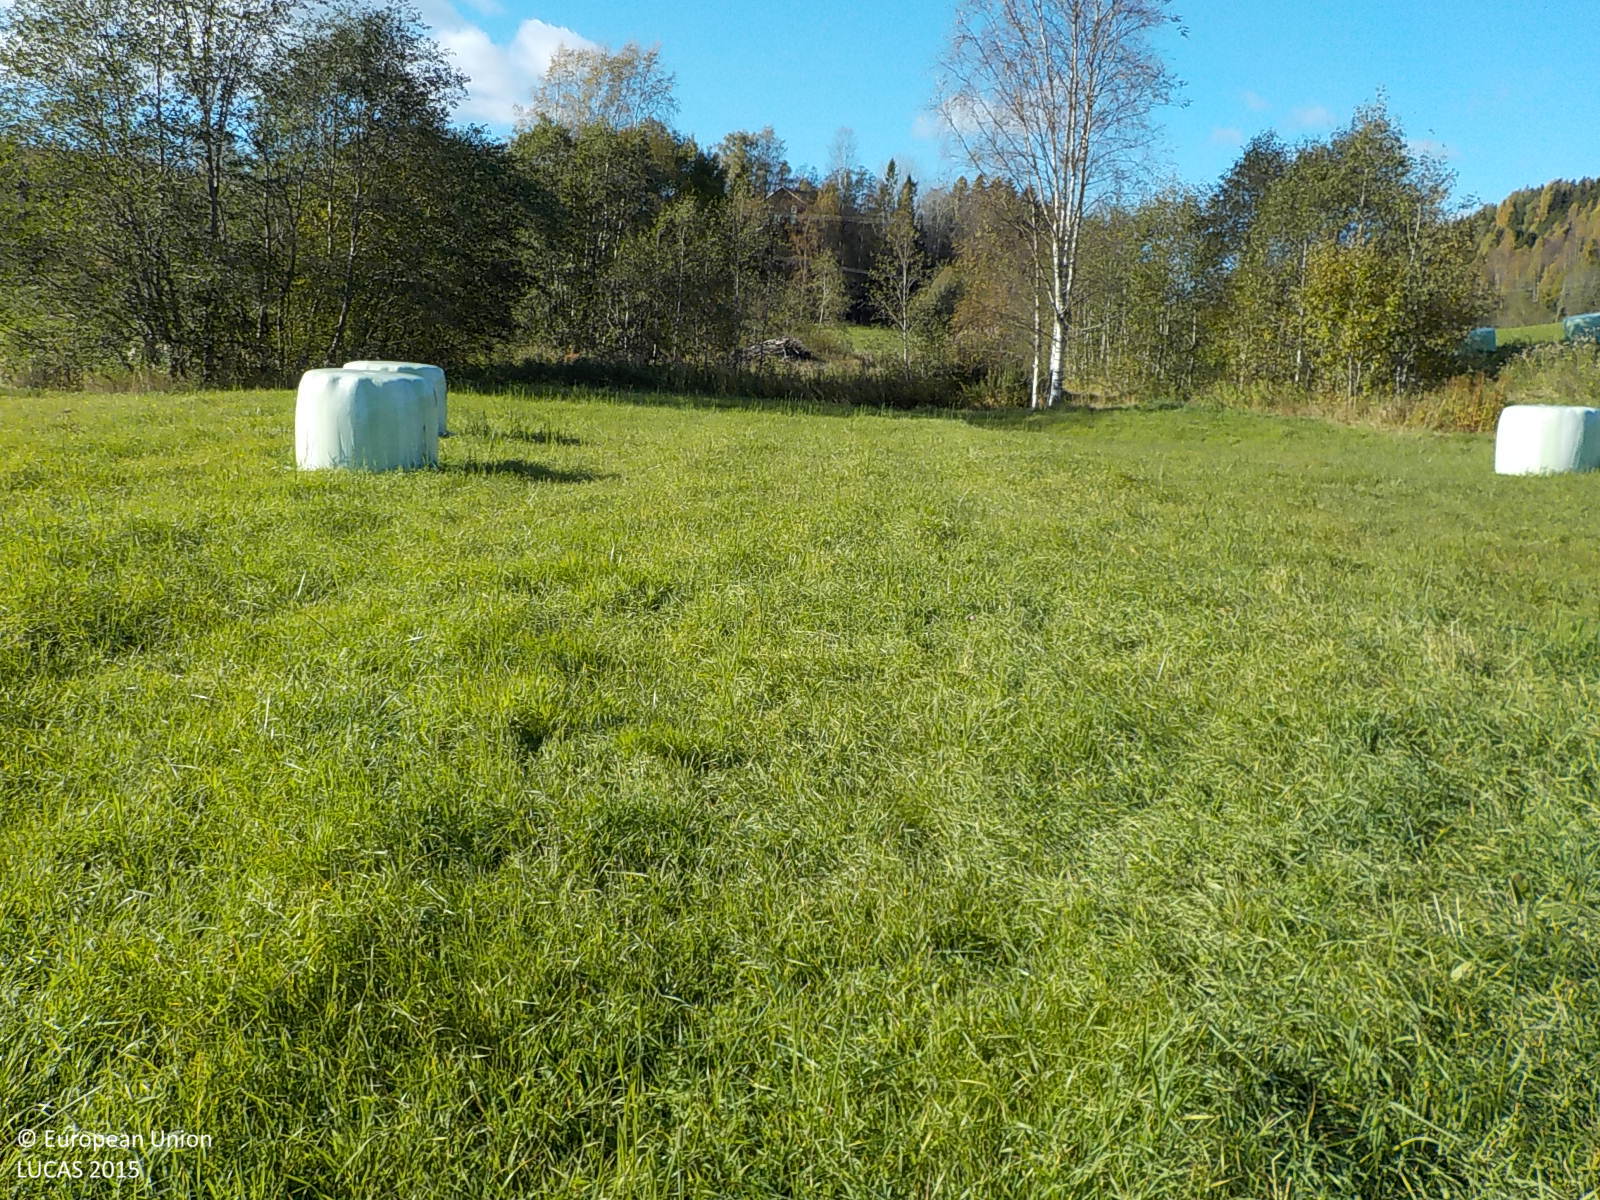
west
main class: Cropland
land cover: Other leguminous and mixtures for fodder
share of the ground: > 75 %
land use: Agriculture (excluding fallow land and kitchen gardens)
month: September
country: SE
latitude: 62.9249
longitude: 18.3492
